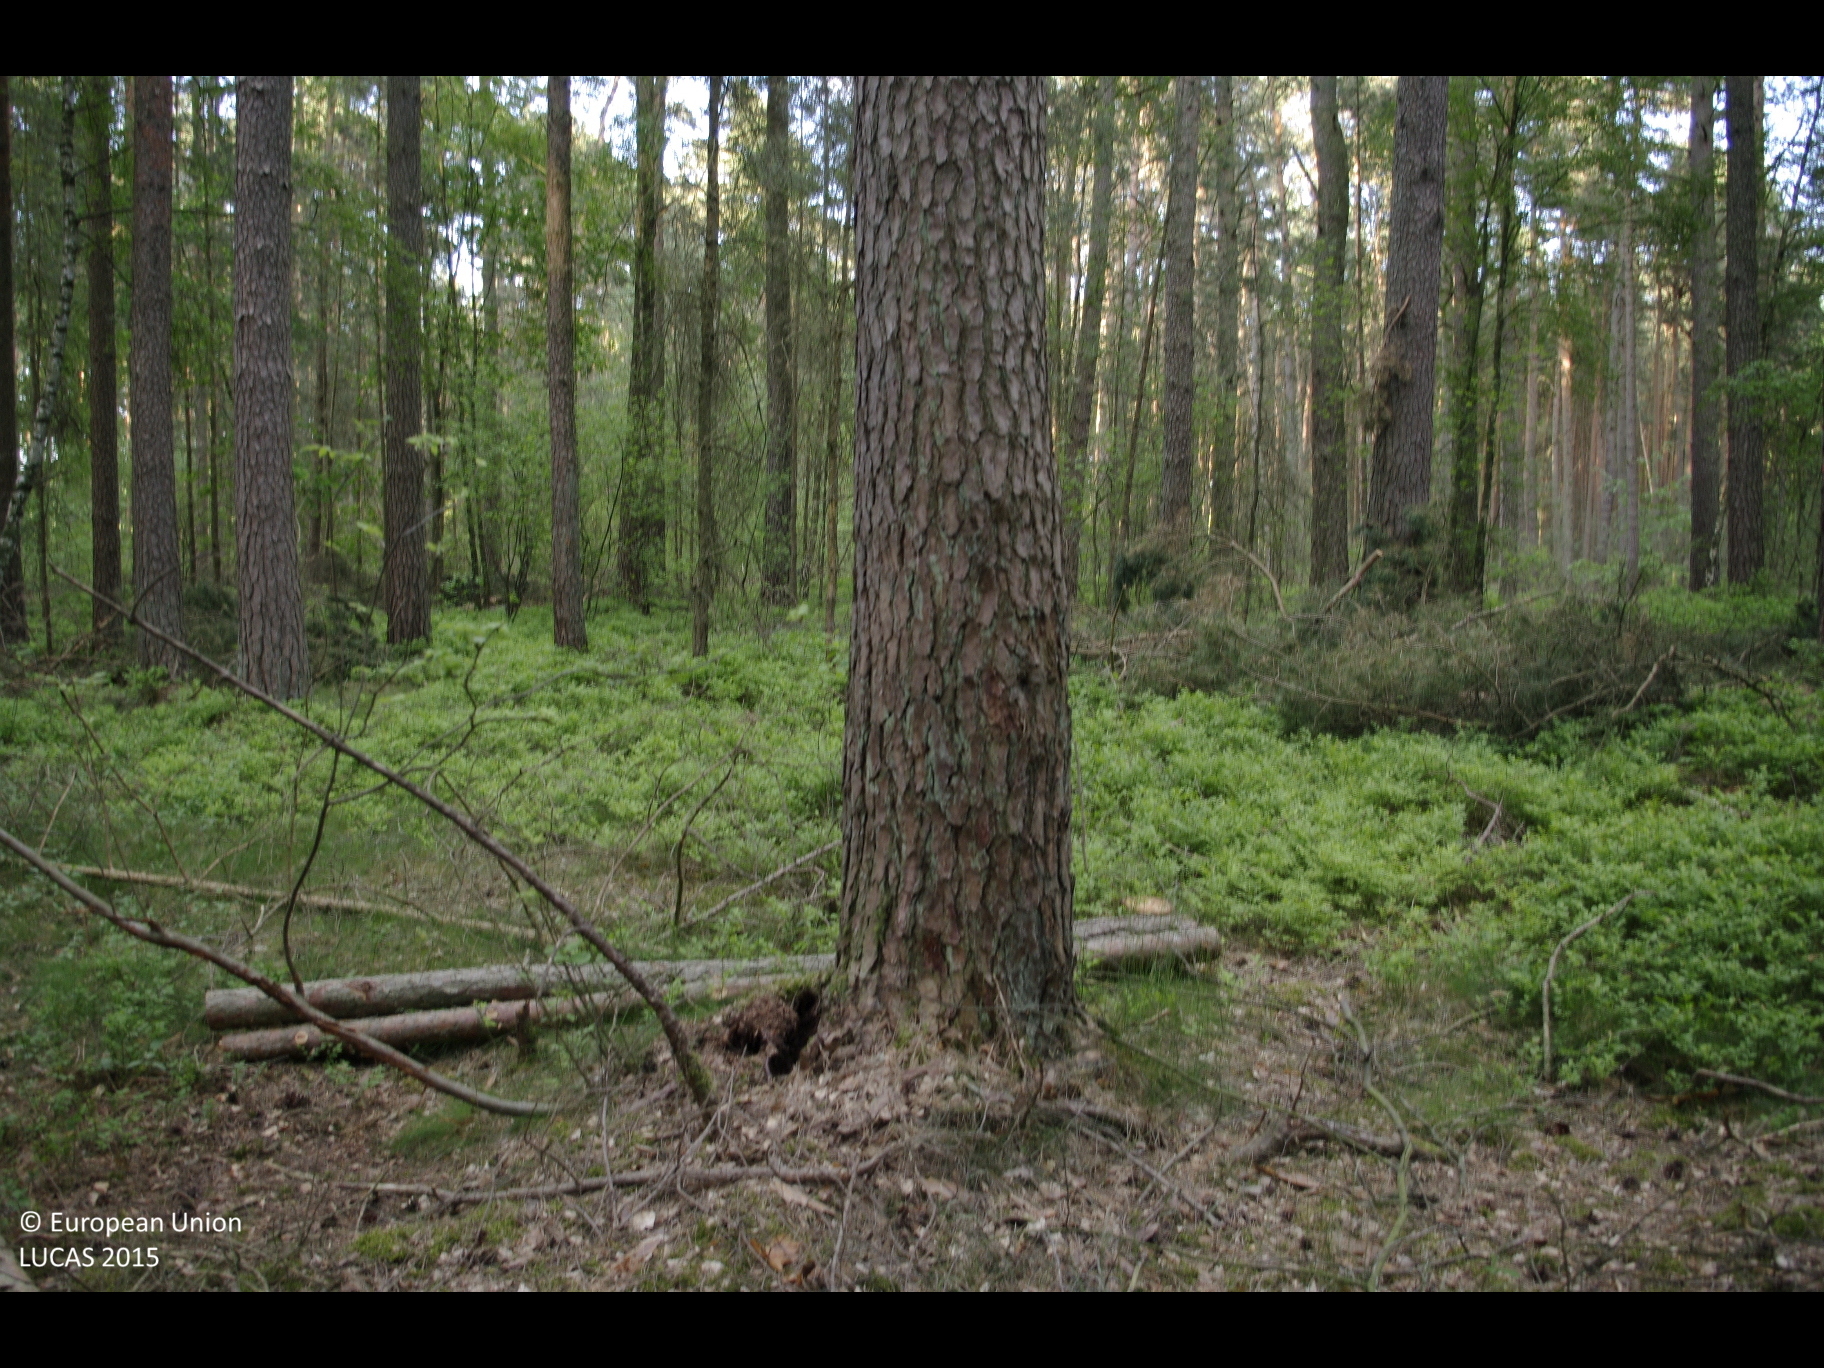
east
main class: Woodland
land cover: Pine dominated mixed woodland
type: hemiboreal forest and nemoral coniferous forest and mixed broadleaved-coniferous forest
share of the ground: 50 - 75 %
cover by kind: coniferous forest trees 50 %, broadleaved forest trees 25 %, shrubs 20 %, herbaceous plants 5 %
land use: Forestry
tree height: > 5 m
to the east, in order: Pine dominated mixed woodland; Other mixed woodland; Rye
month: June
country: DE
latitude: 53.2206
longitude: 10.6138
